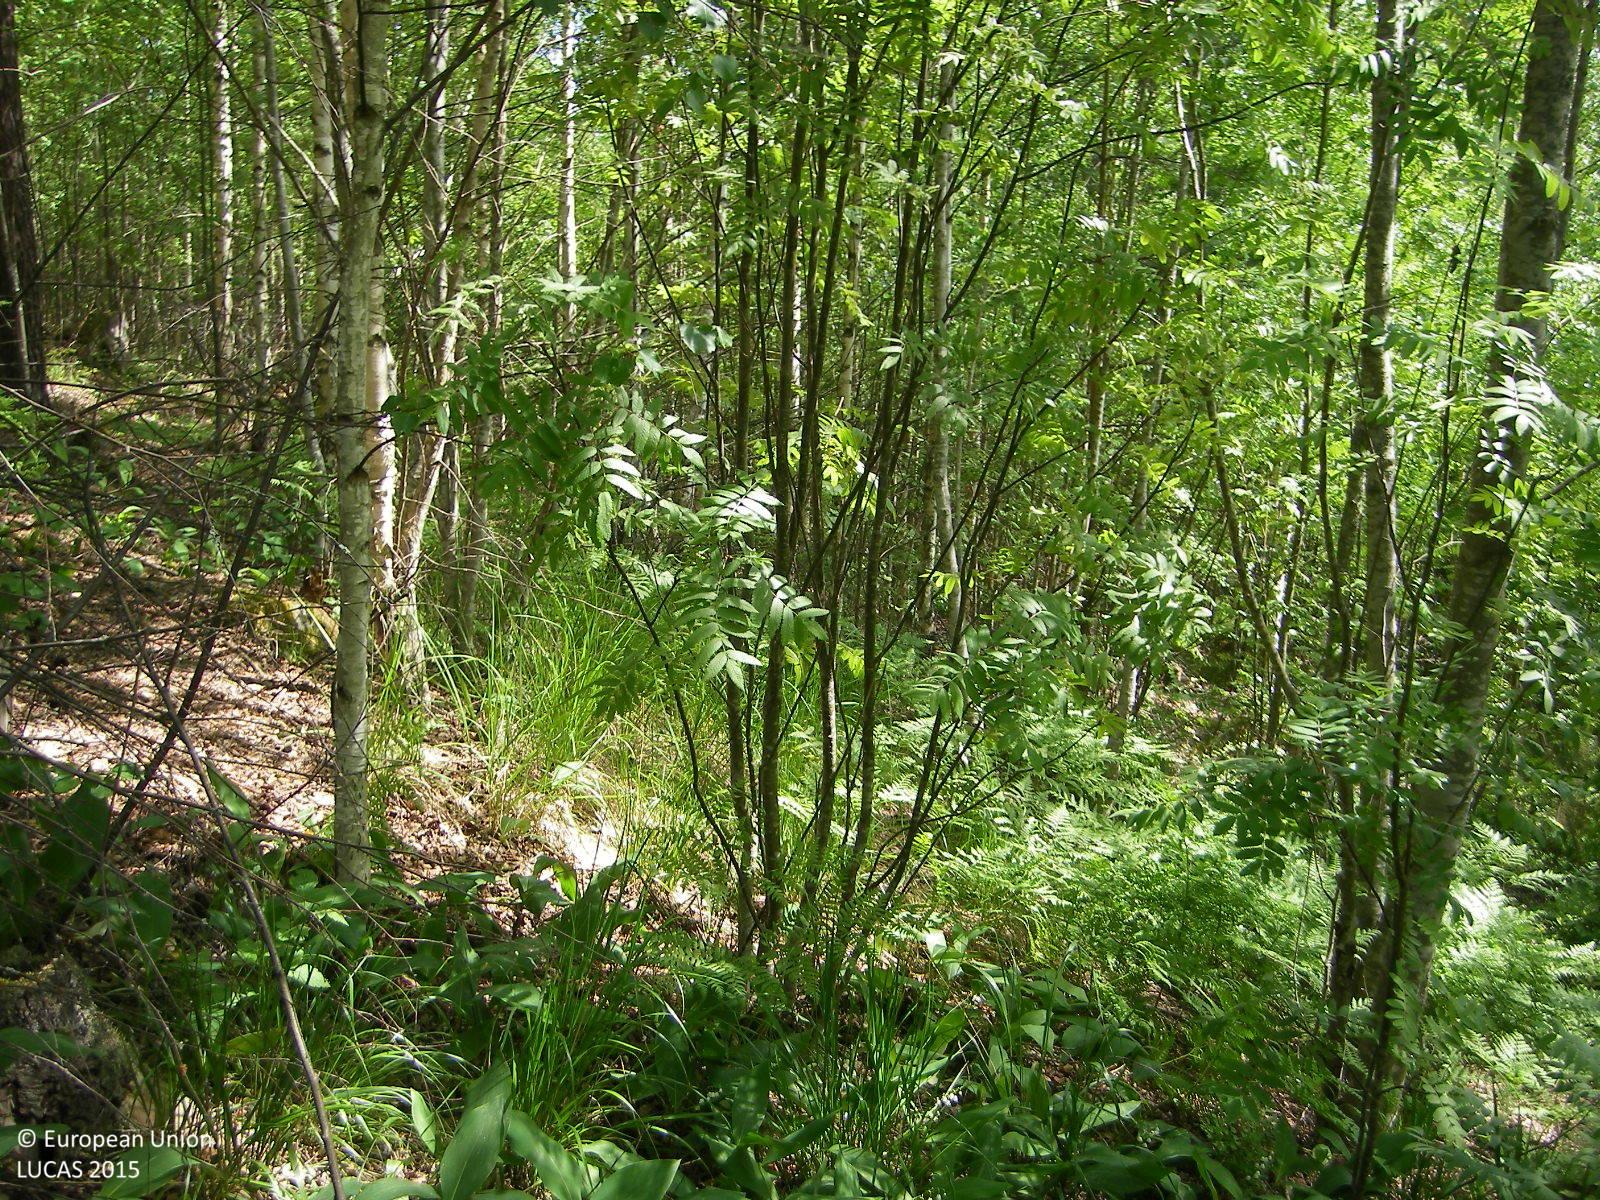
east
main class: Woodland
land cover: Broadleaved woodland
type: boreal forest
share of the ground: > 75 %
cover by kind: broadleaved forest trees 70 %, herbaceous plants 20 %, coniferous forest trees 5 %, lichens and mosses 5 %
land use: Forestry
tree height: > 5 m
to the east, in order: Broadleaved woodland; Spruce dominated mixed woodland; Artificial constructions in urban areas; Ditches and canals; Paved roads, cycling and walking lanes; Grass margins; Ditches and canals; Other bare soil
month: June
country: FI
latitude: 60.4306
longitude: 24.3649
